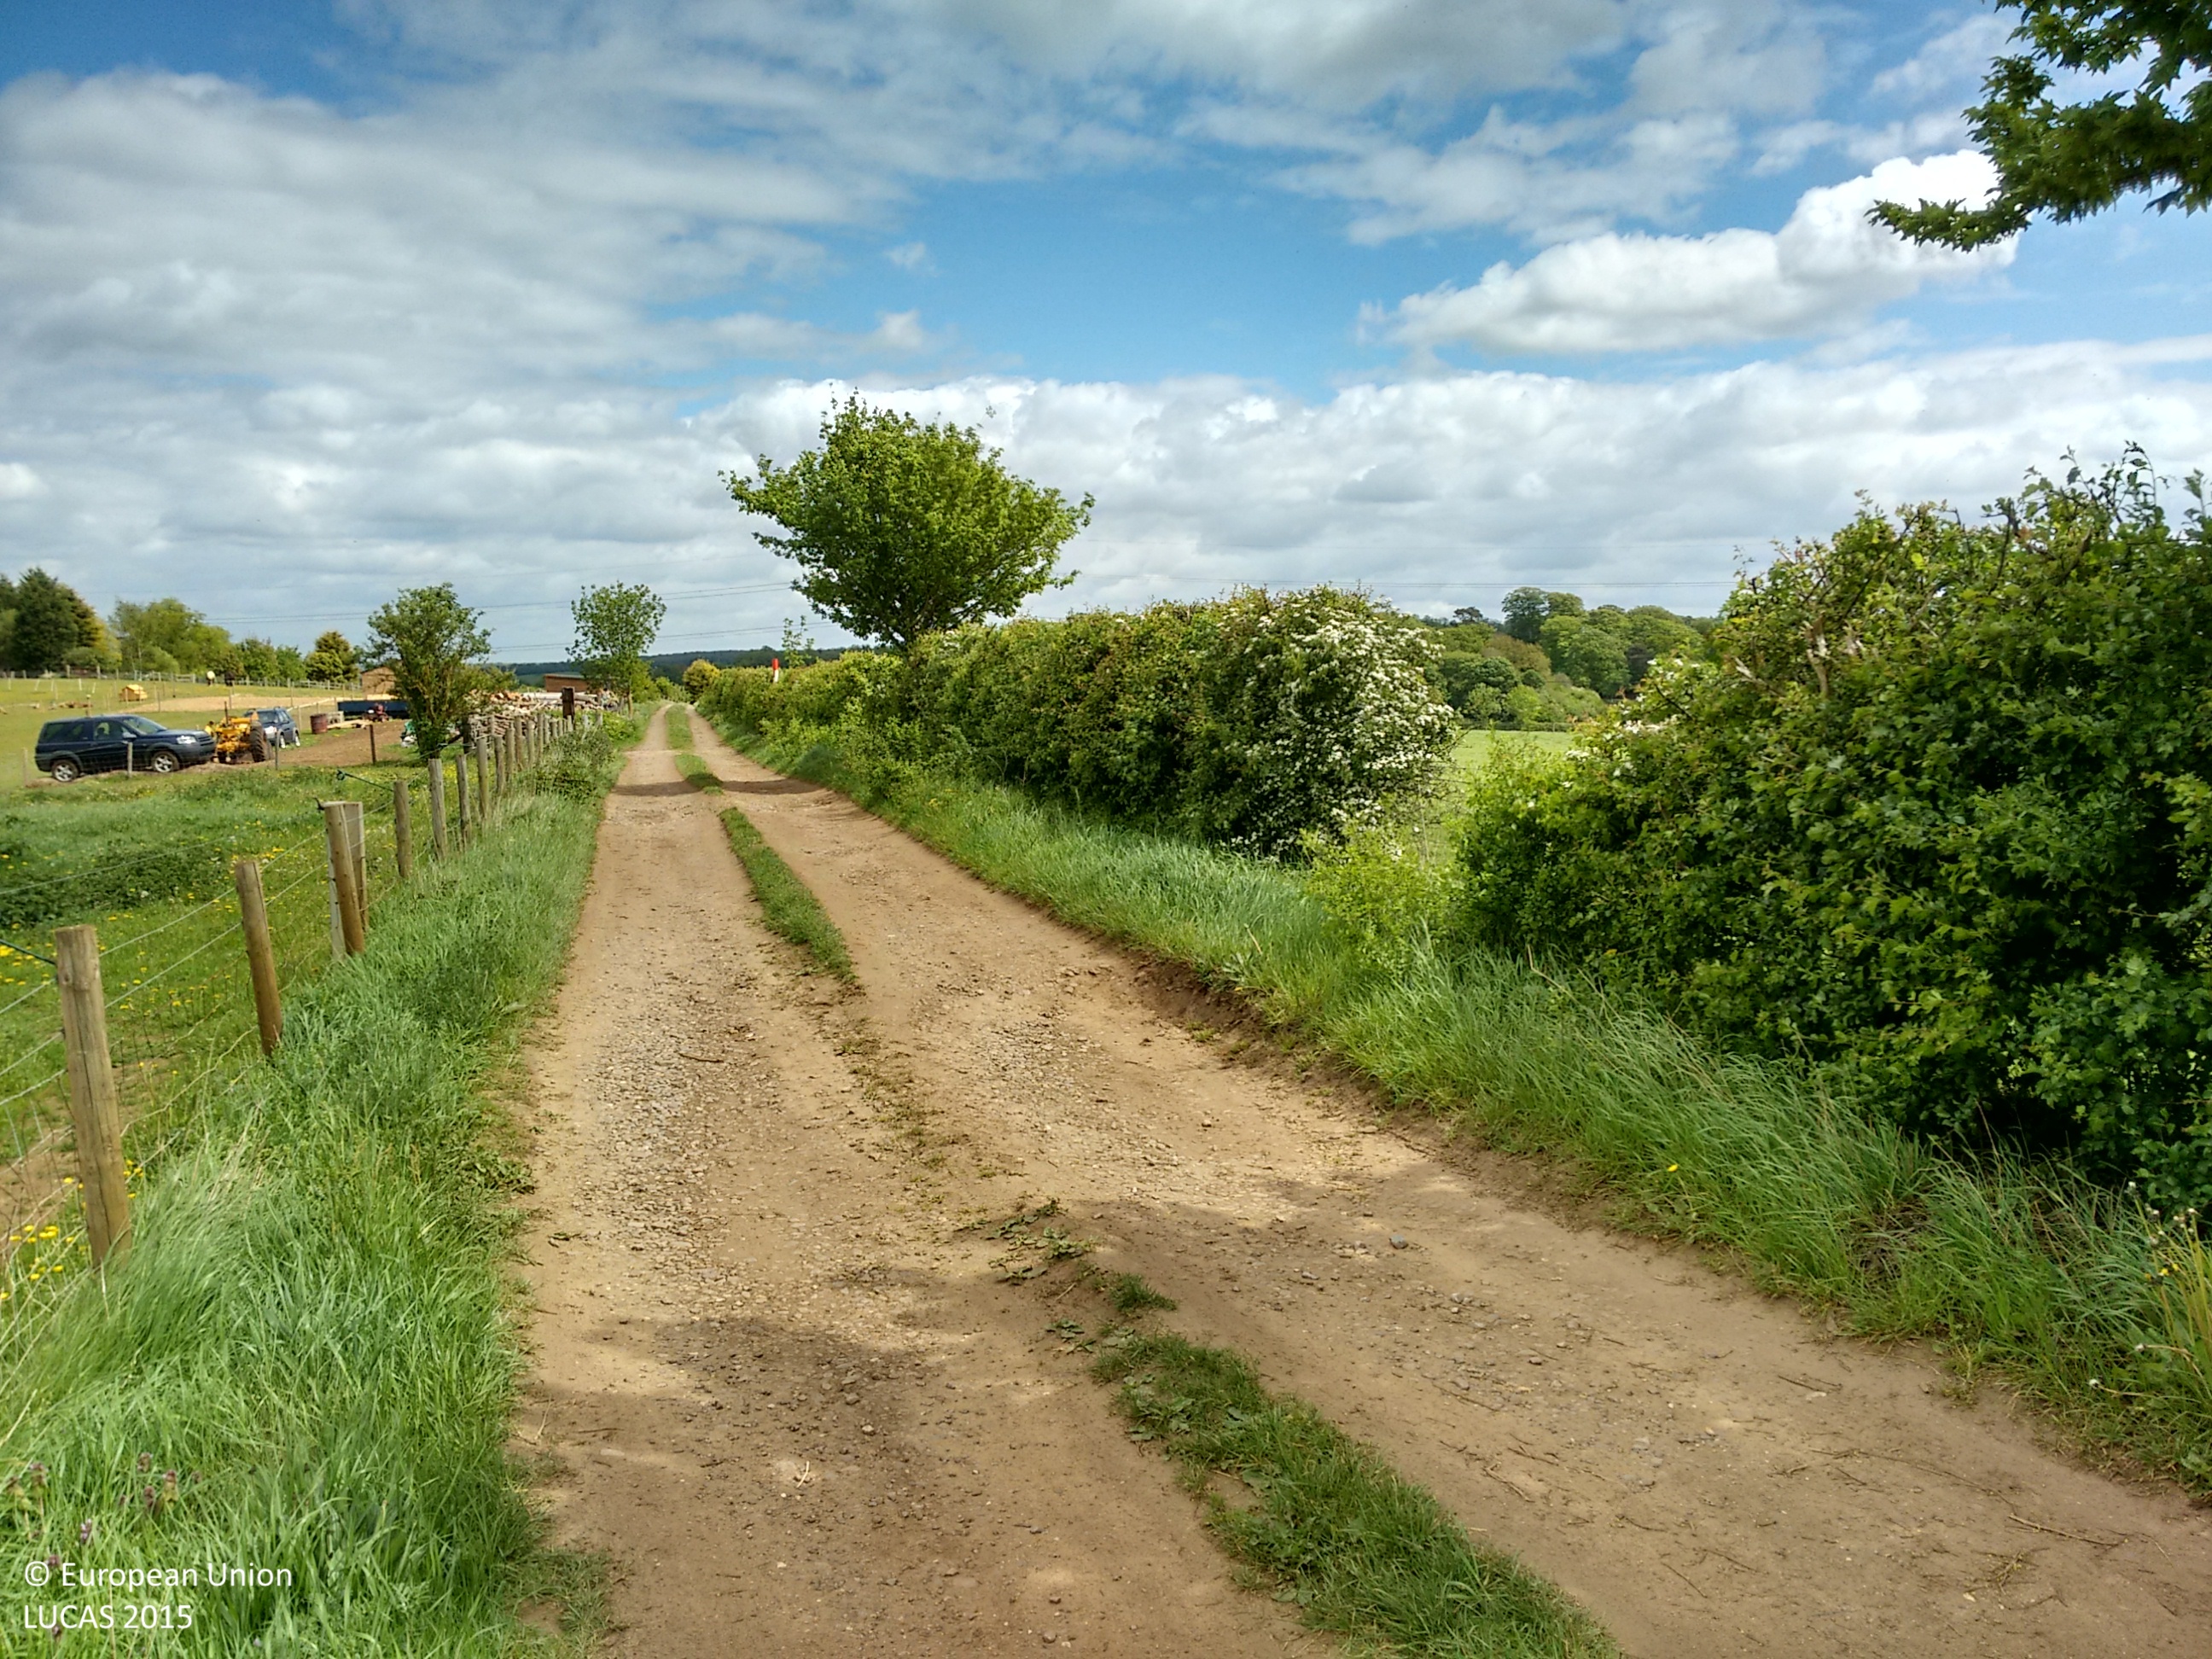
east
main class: Grassland
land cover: Grassland without tree/shrub cover
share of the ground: > 75 %
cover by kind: herbaceous plants 100 %
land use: Amenities, museums, leisure
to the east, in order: Grassland without tree/shrub cover; Fences; Grassland without tree/shrub cover; Fences; Tracks; Grassland without tree/shrub cover; Paved roads, cycling and walking lanes; Managed hedges; Fences; Grassland without tree/shrub cover; Managed hedges; Grassland without tree/shrub cover
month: May
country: GB
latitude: 52.0356
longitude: -0.5197
